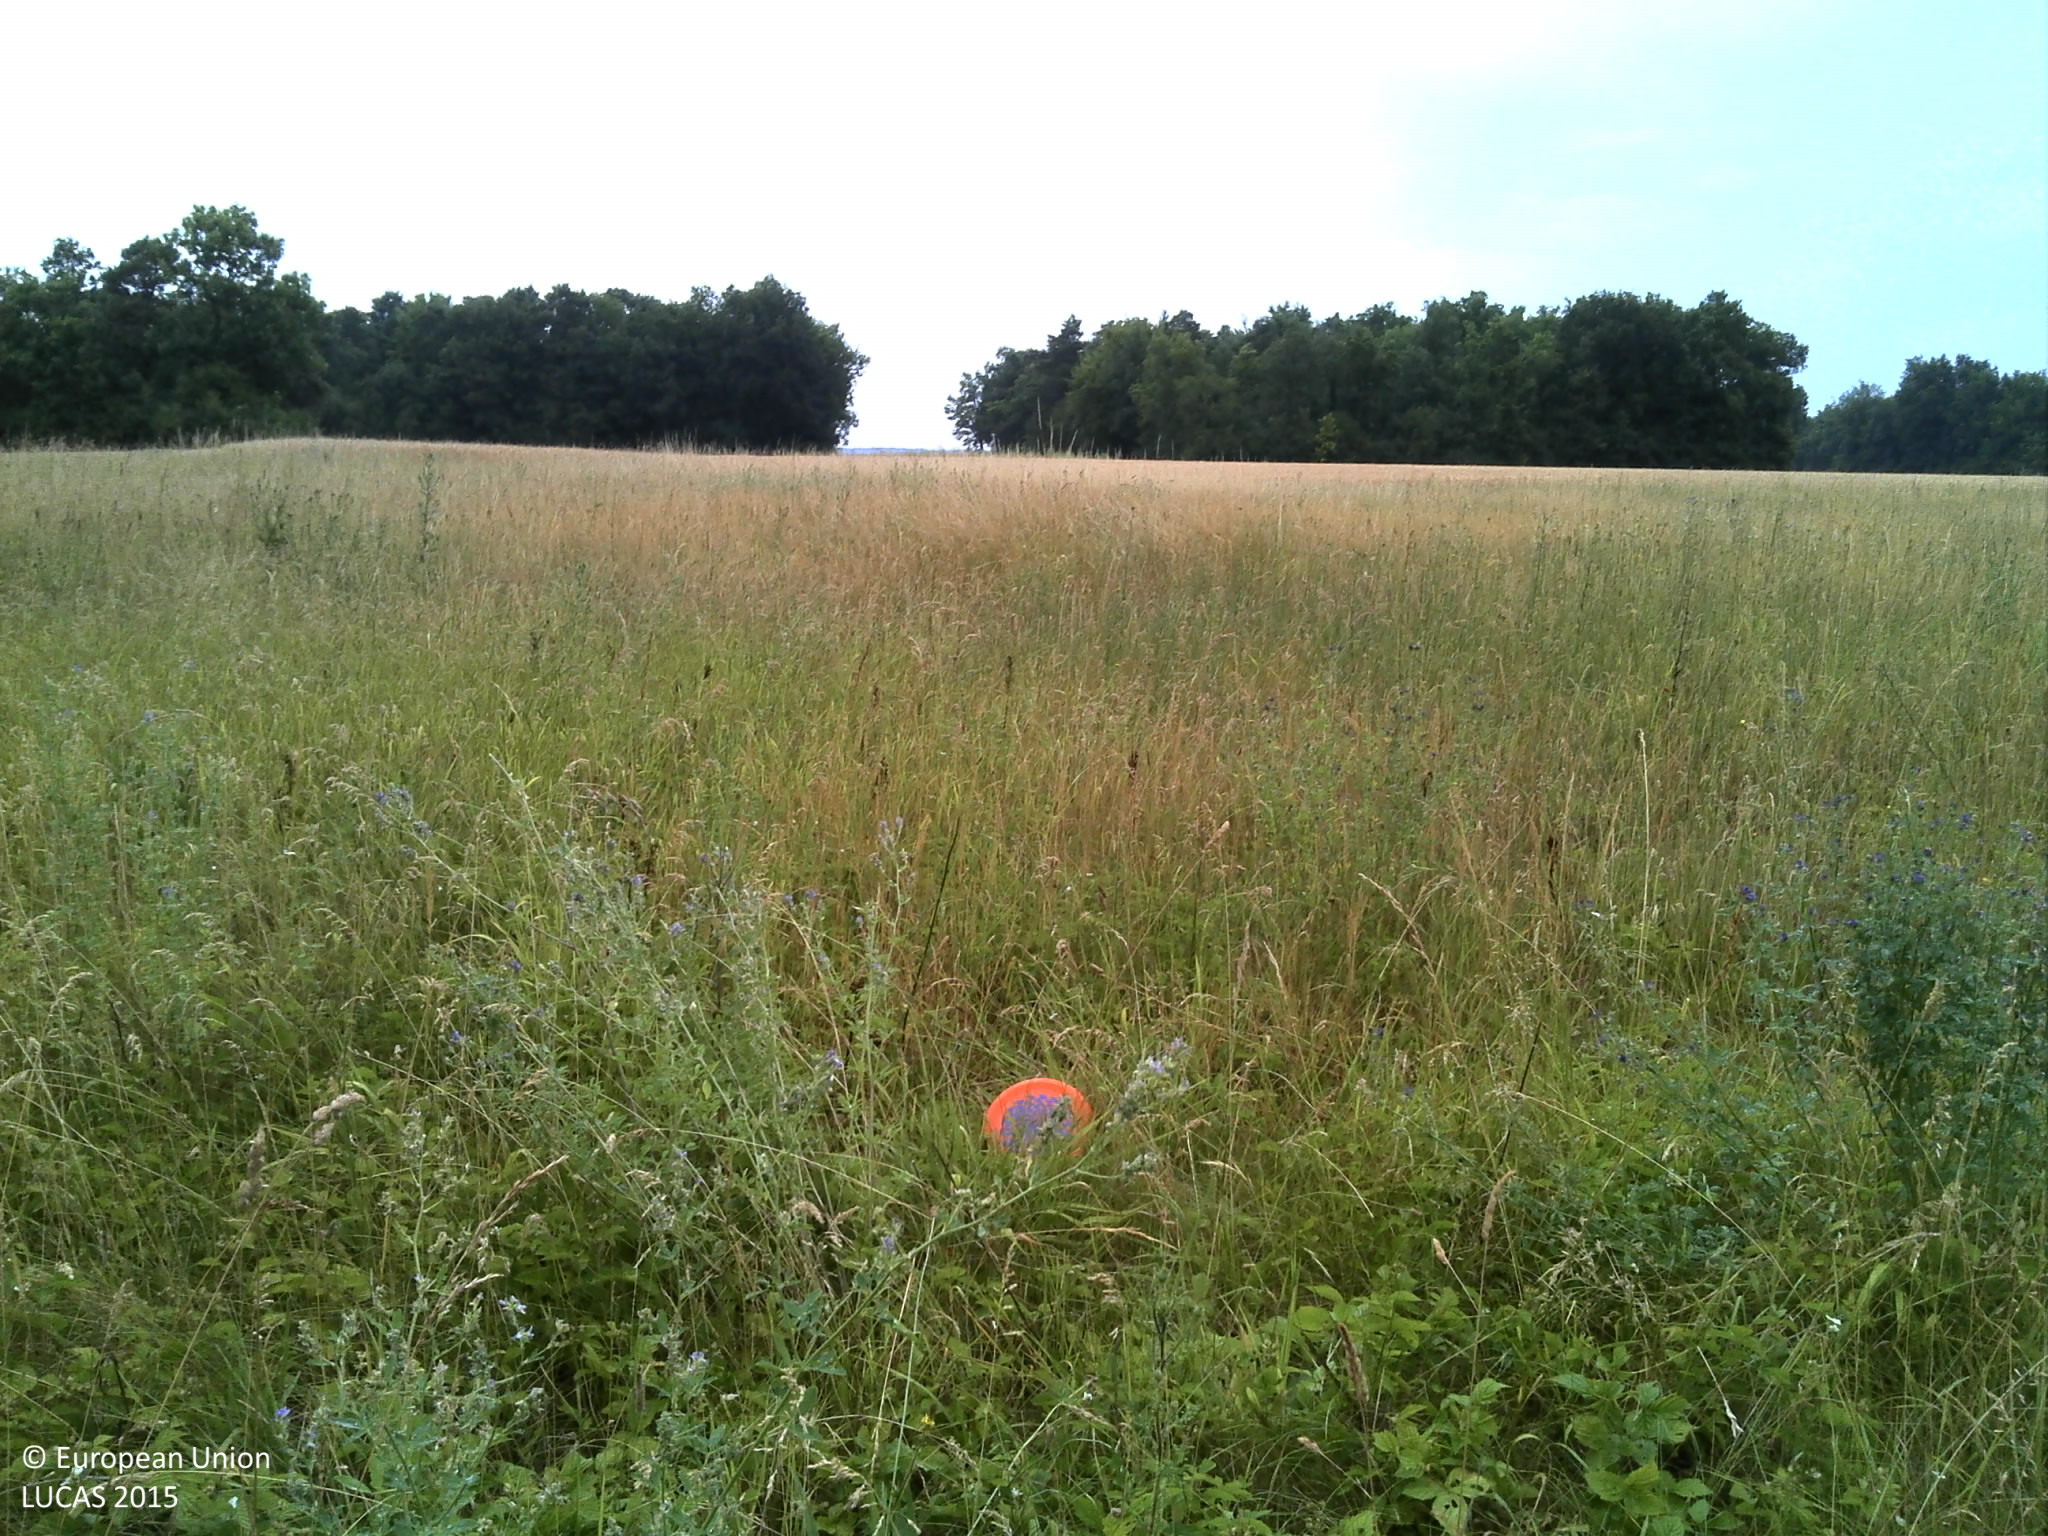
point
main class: Grassland
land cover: Grassland without tree/shrub cover
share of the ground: > 75 %
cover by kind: herbaceous plants 100 %
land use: Agriculture (excluding fallow land and kitchen gardens)
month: July
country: FR
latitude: 48.2543
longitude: 2.4606
